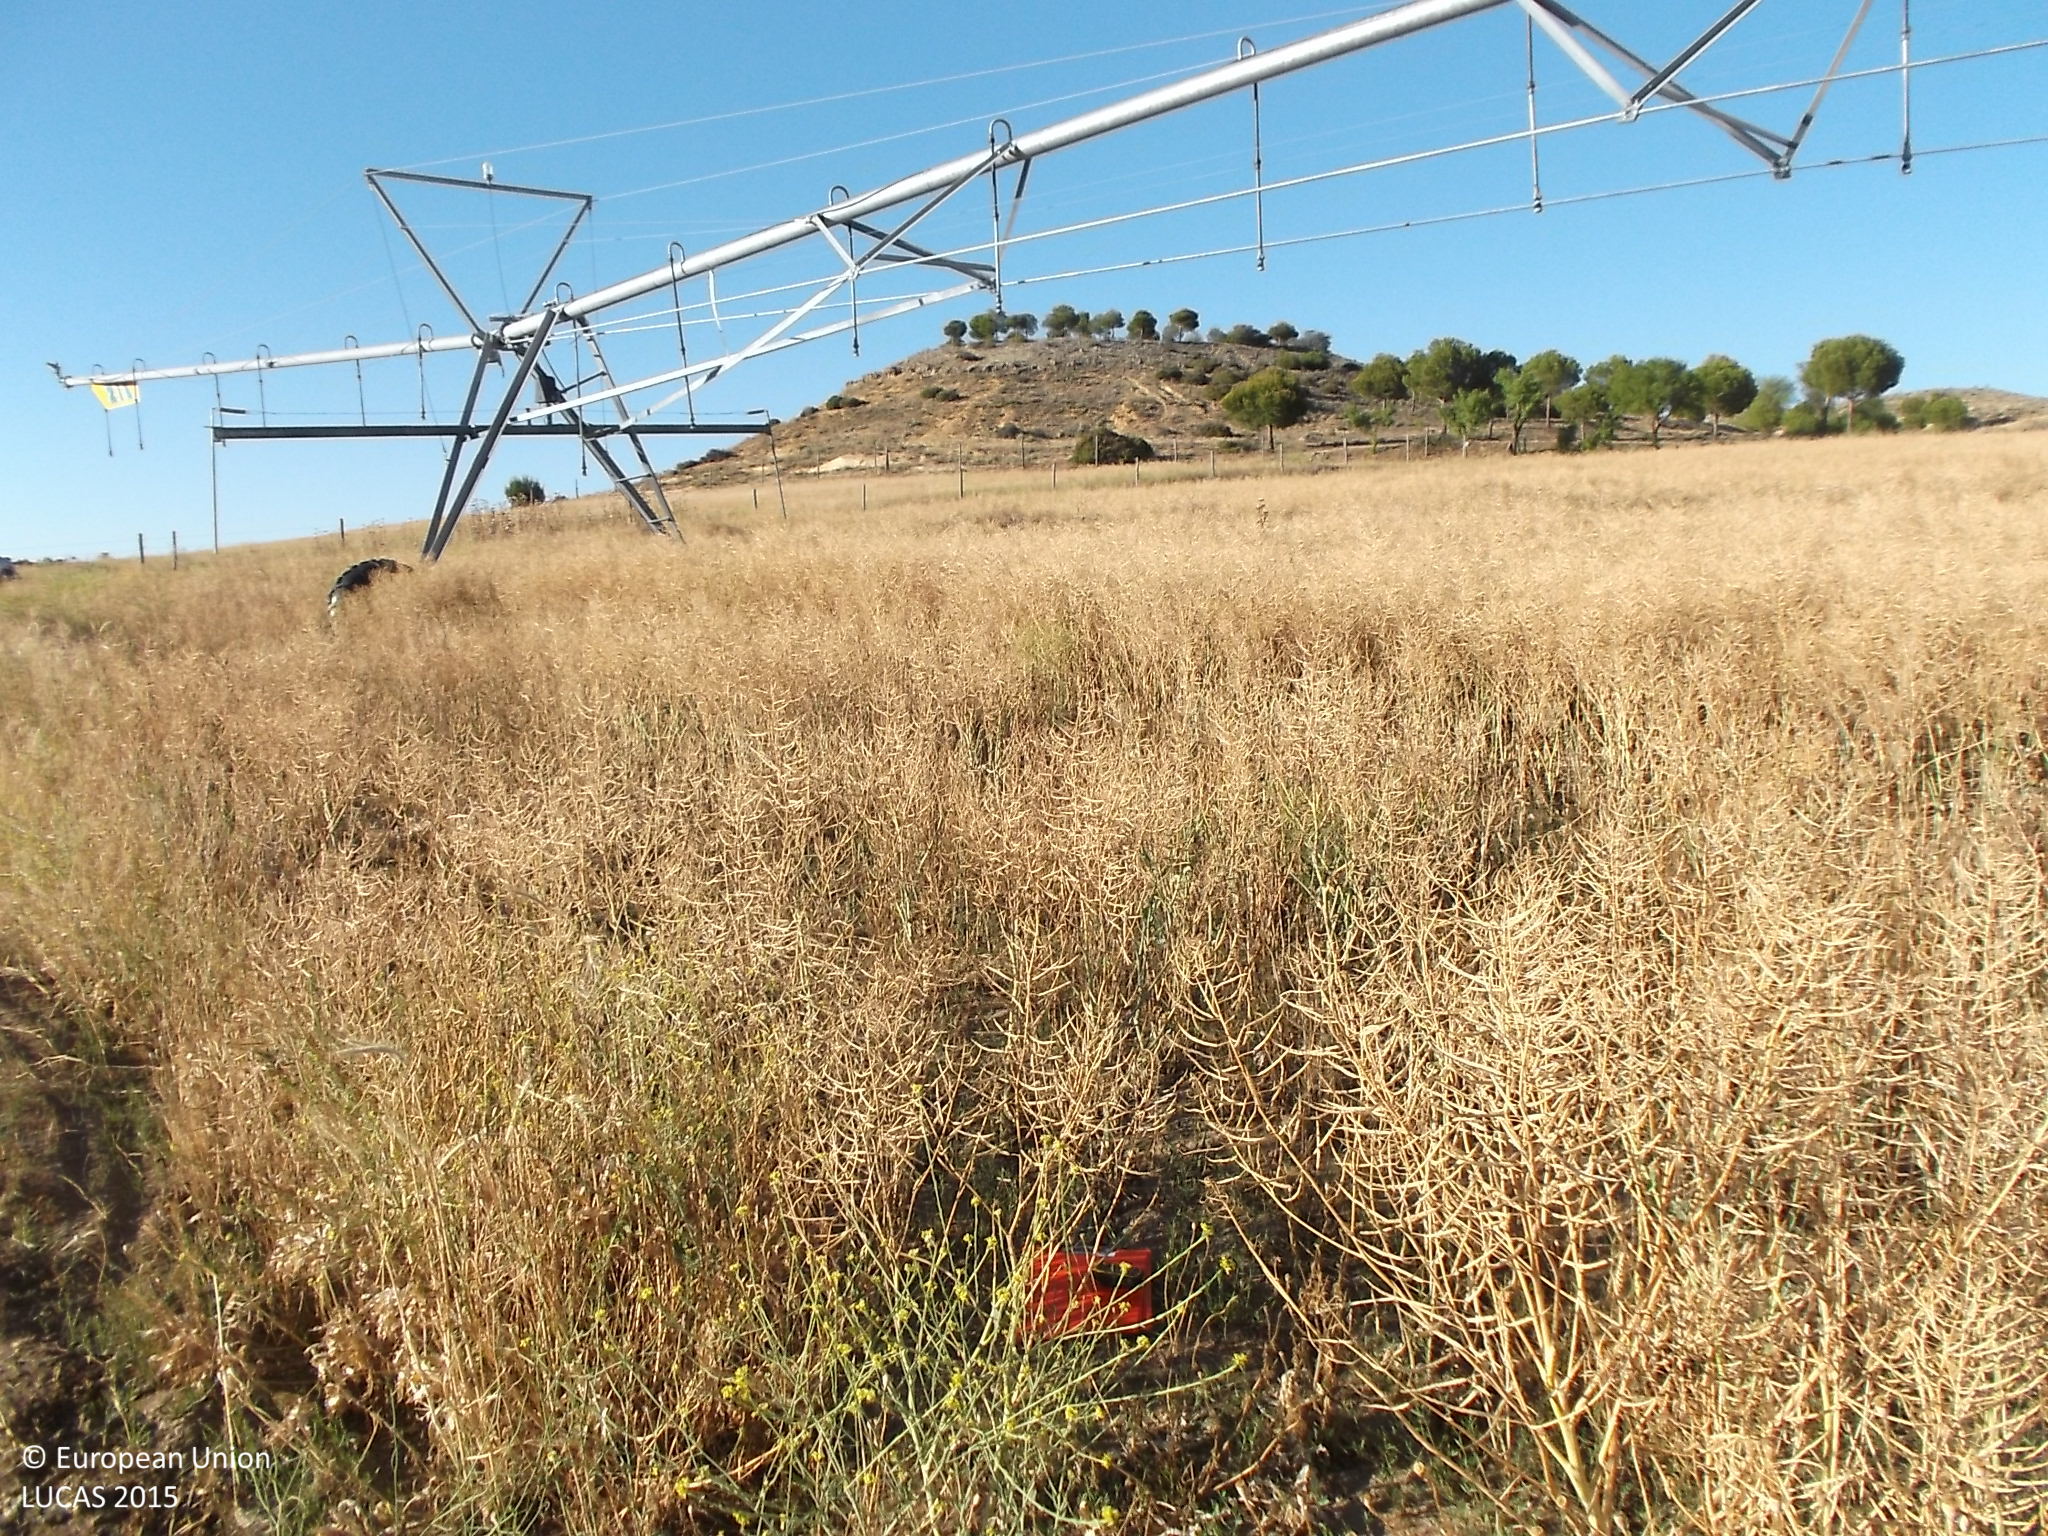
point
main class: Cropland
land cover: Rape and turnip rape
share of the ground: > 75 %
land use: Agriculture (excluding fallow land and kitchen gardens)
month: June
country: ES
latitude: 41.2749
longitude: -5.3444
